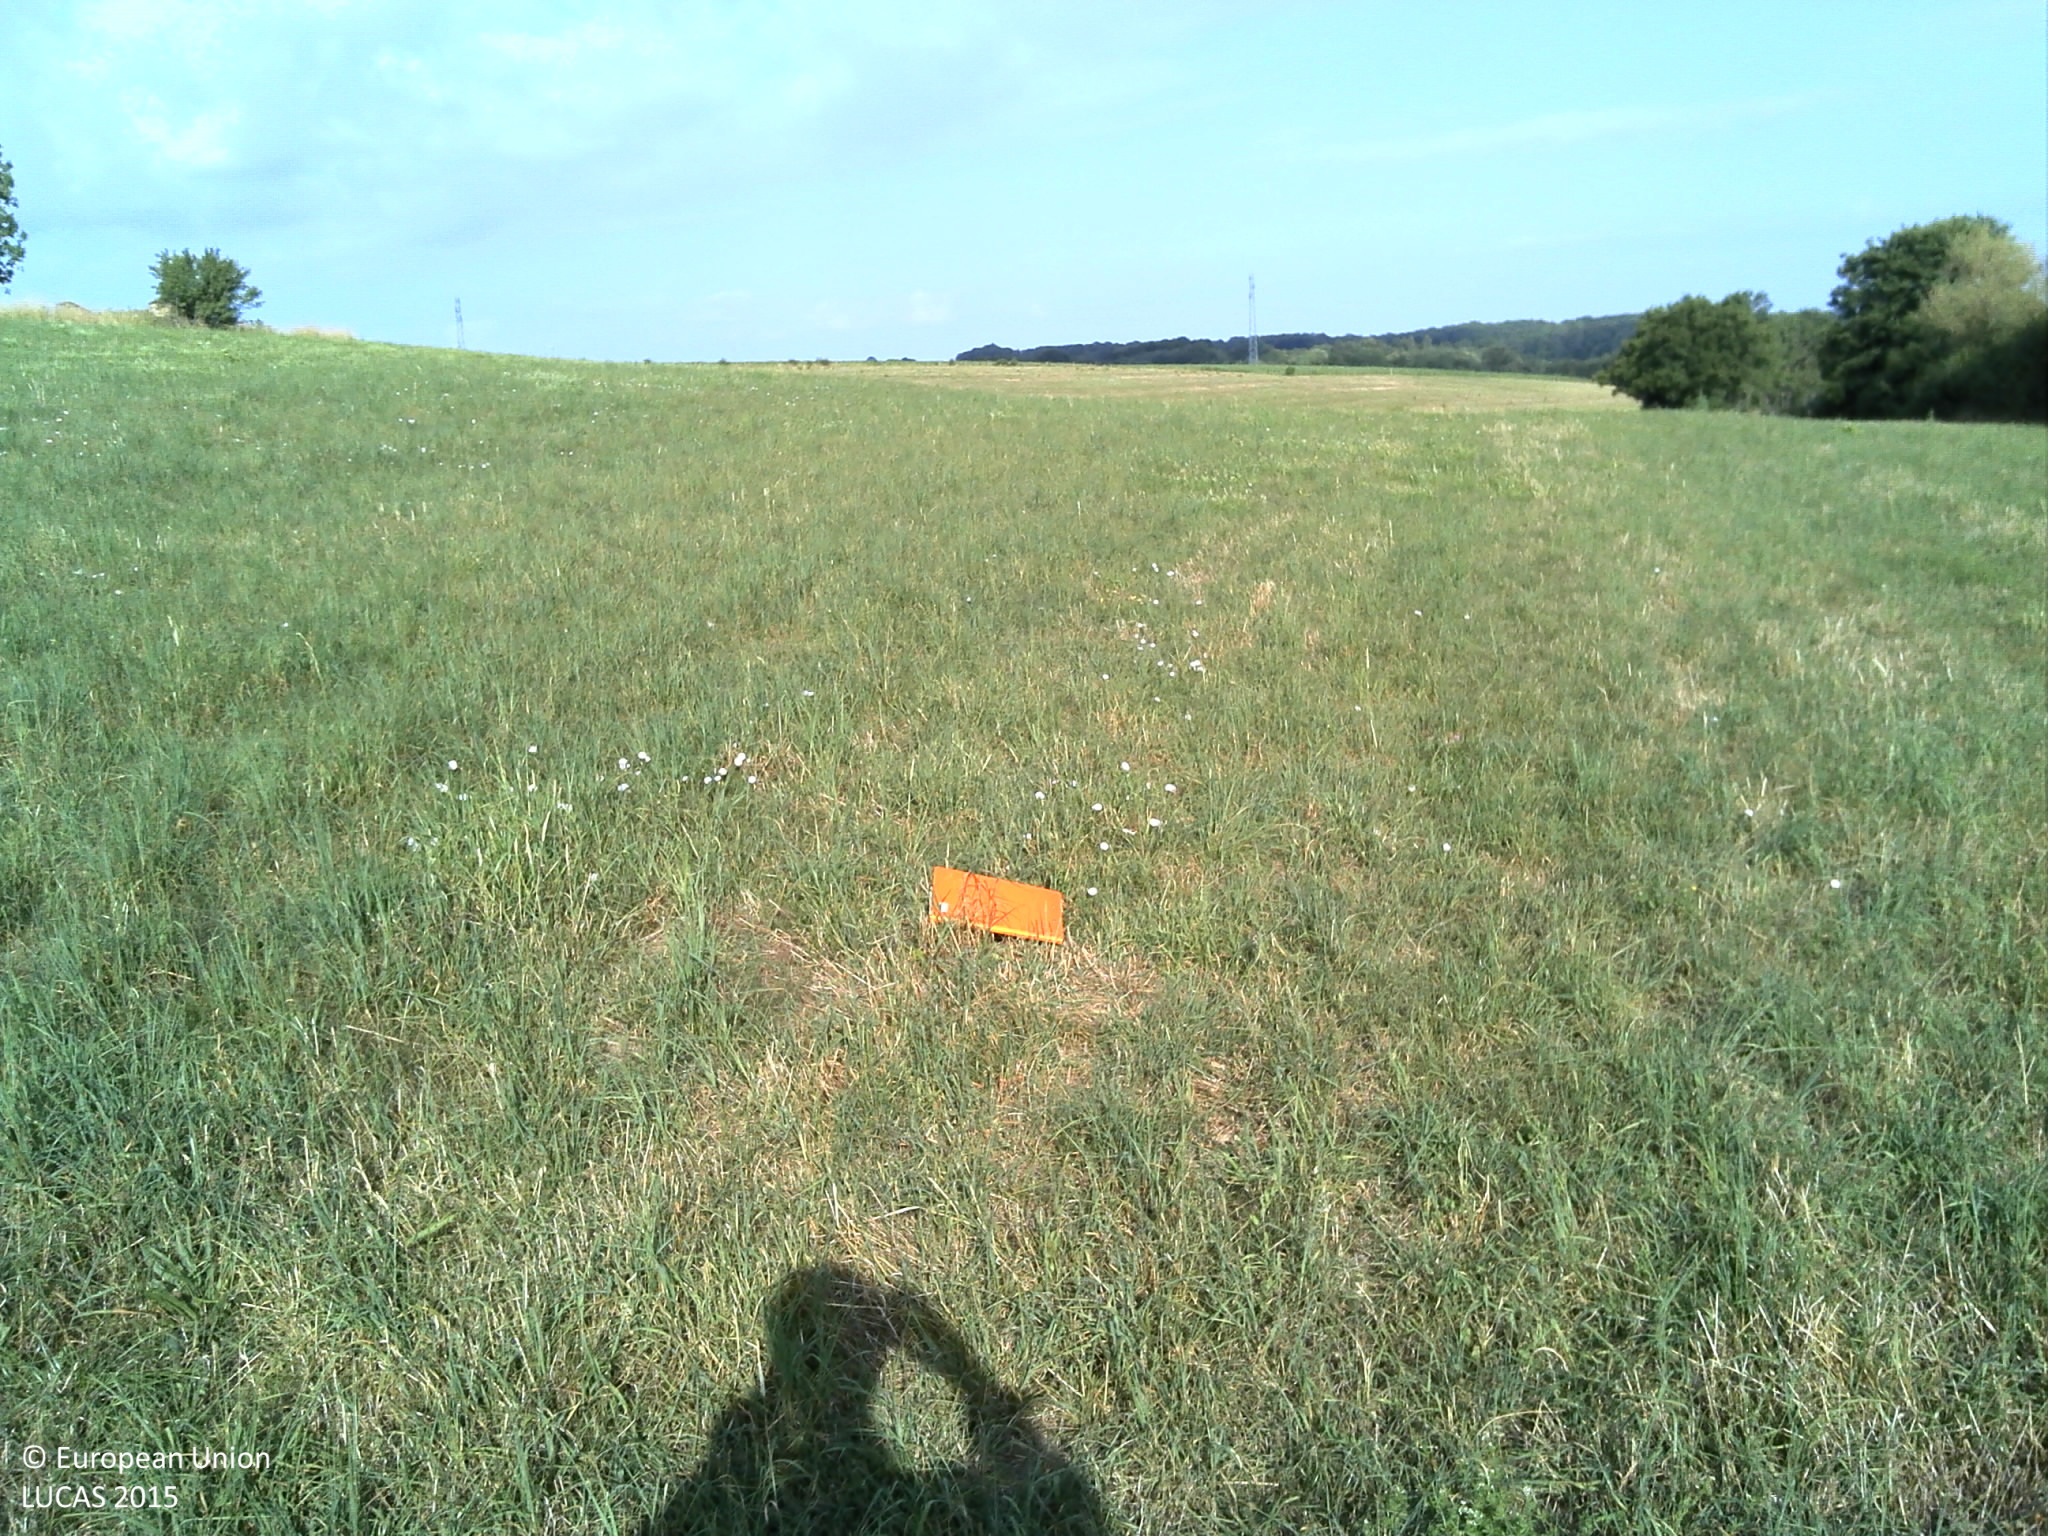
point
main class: Grassland
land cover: Grassland without tree/shrub cover
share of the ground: > 75 %
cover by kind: herbaceous plants 100 %
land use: Agriculture (excluding fallow land and kitchen gardens)
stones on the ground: 10 - 25 %
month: July
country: FR
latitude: 48.1796
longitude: 6.3021
